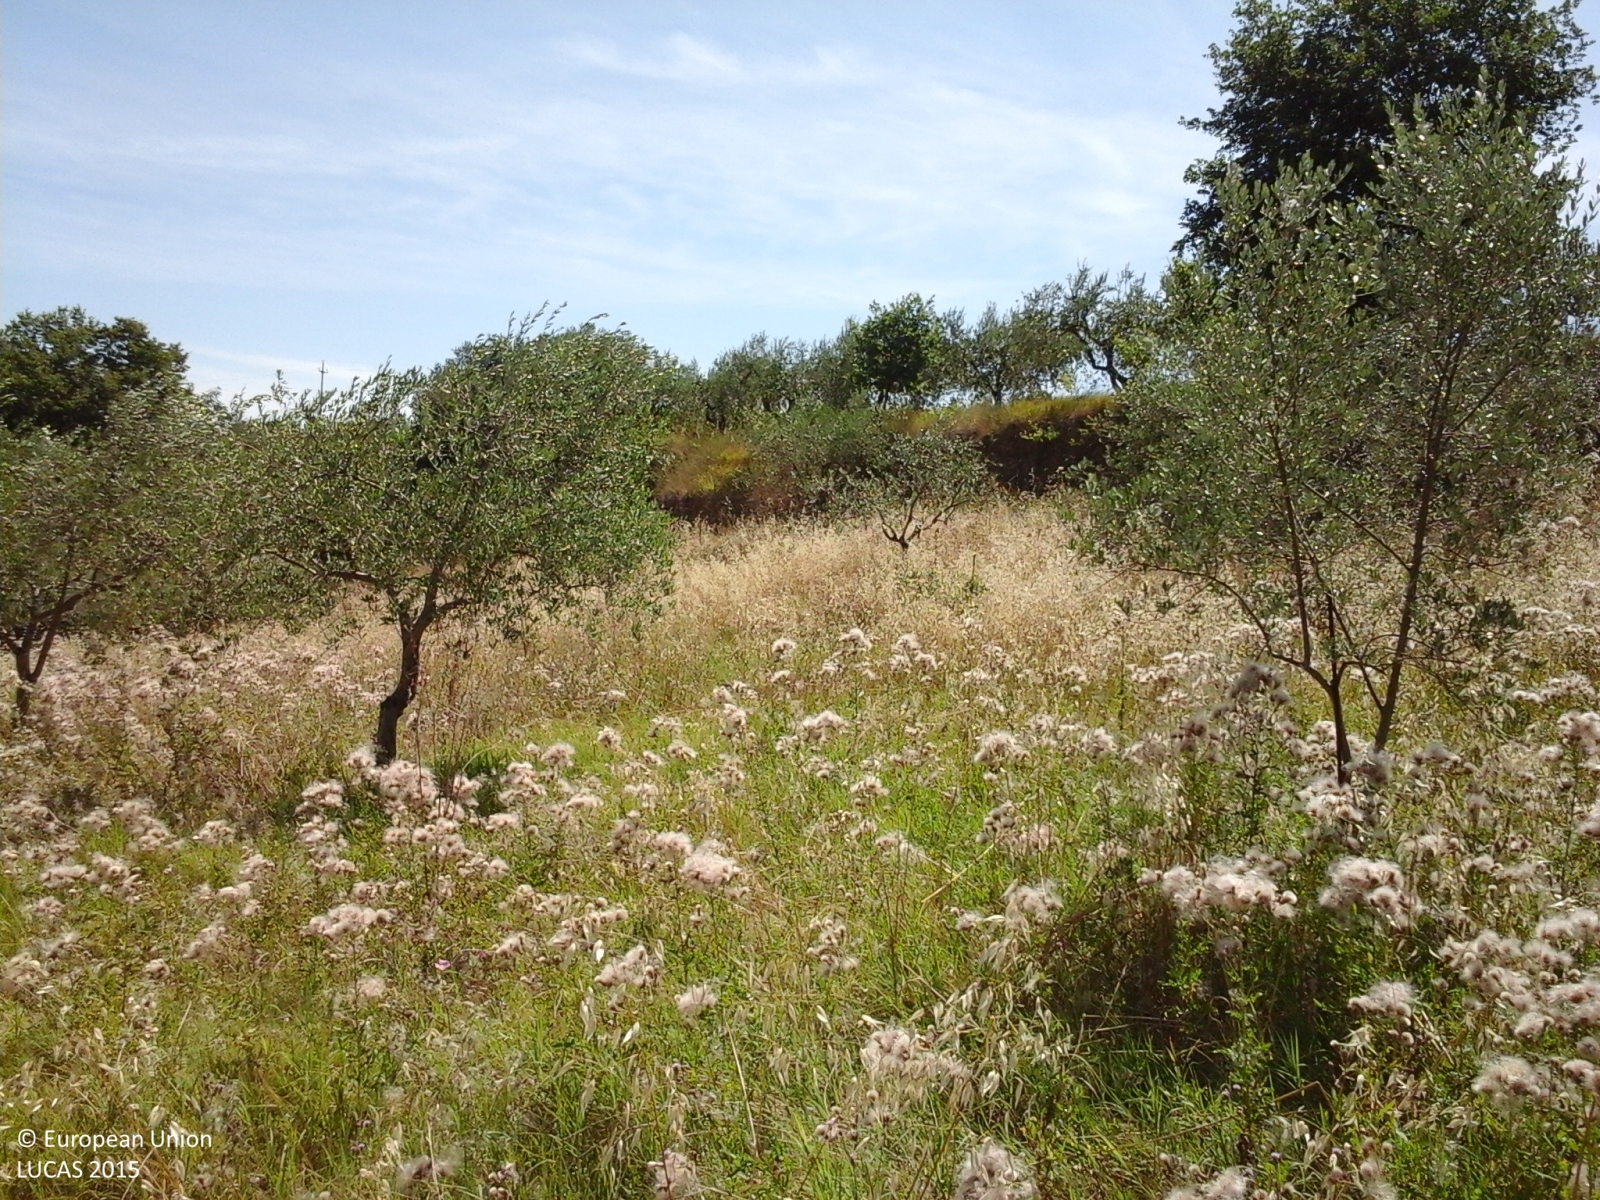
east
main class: Cropland
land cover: Olive groves
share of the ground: 25 - 50 %
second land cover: Spontaneously vegetated surfaces
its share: > 75 %
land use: Agriculture (excluding fallow land and kitchen gardens)
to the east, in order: Olive groves; Spontaneously vegetated surfaces; Olive groves; Spontaneously vegetated surfaces; Vineyards; Fences; Ditches and canals; Conifer hedges; Artificial constructions in urban areas; Olive groves
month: June
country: IT
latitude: 42.2685
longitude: 14.4119
